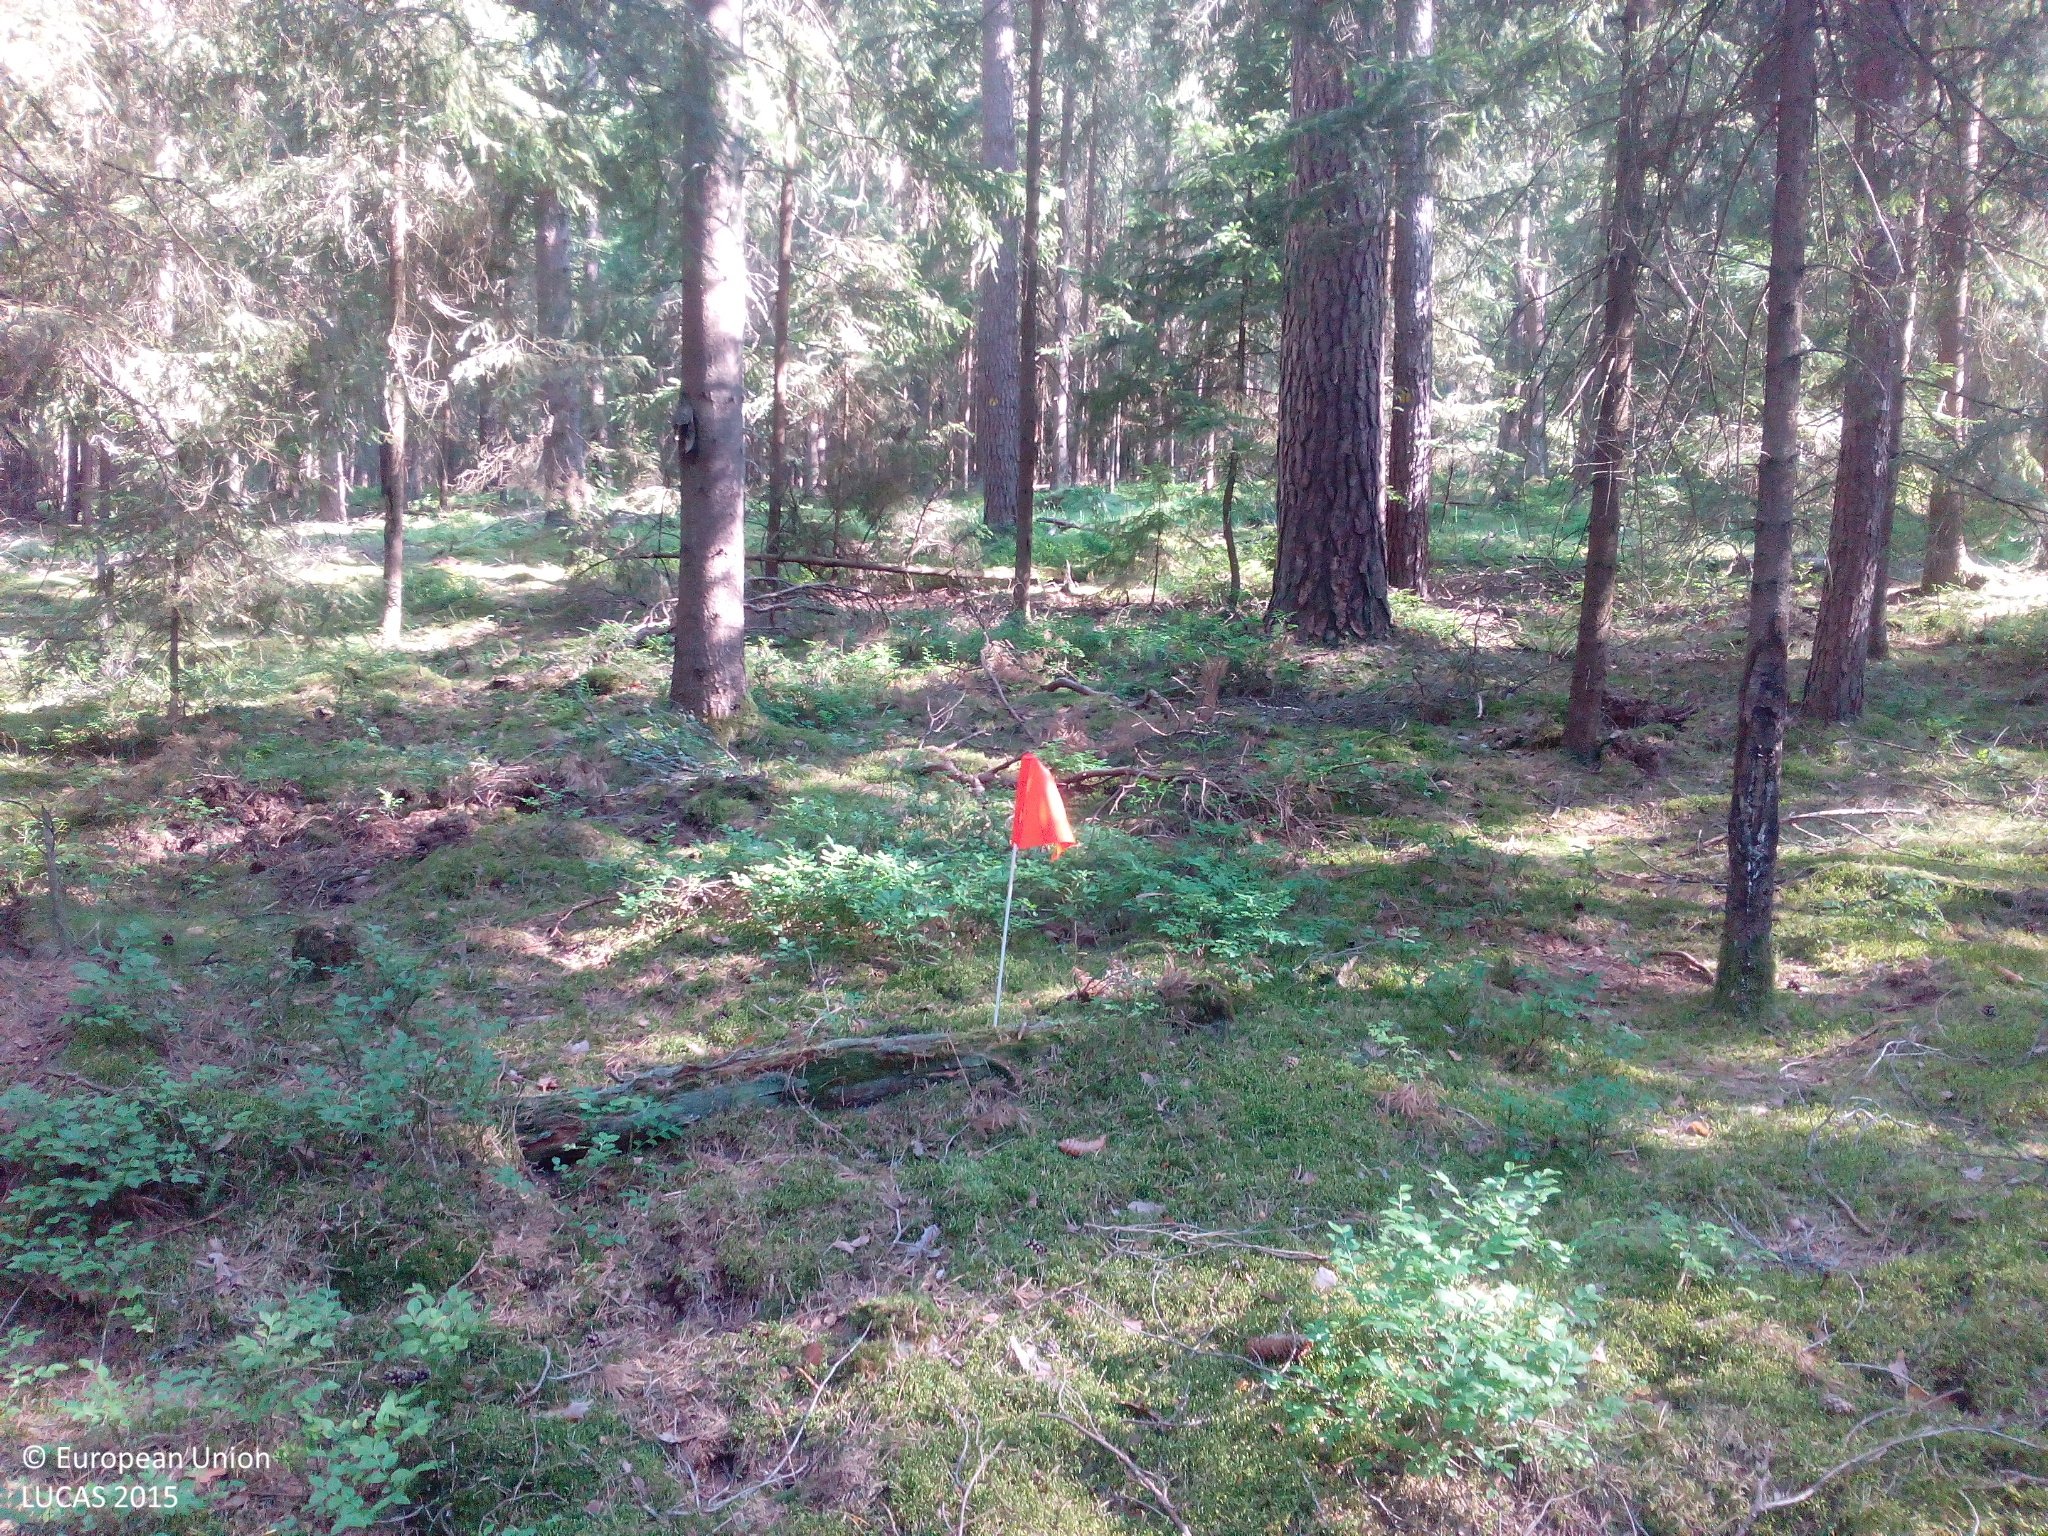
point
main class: Woodland
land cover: Other coniferous woodland
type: hemiboreal forest and nemoral coniferous forest and mixed broadleaved-coniferous forest
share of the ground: 50 - 75 %
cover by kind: coniferous forest trees 70 %, shrubs 15 %, lichens and mosses 15 %
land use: Forestry
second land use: Amenities, museums, leisure
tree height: > 5 m
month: July
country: DE
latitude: 49.8210
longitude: 12.2096
